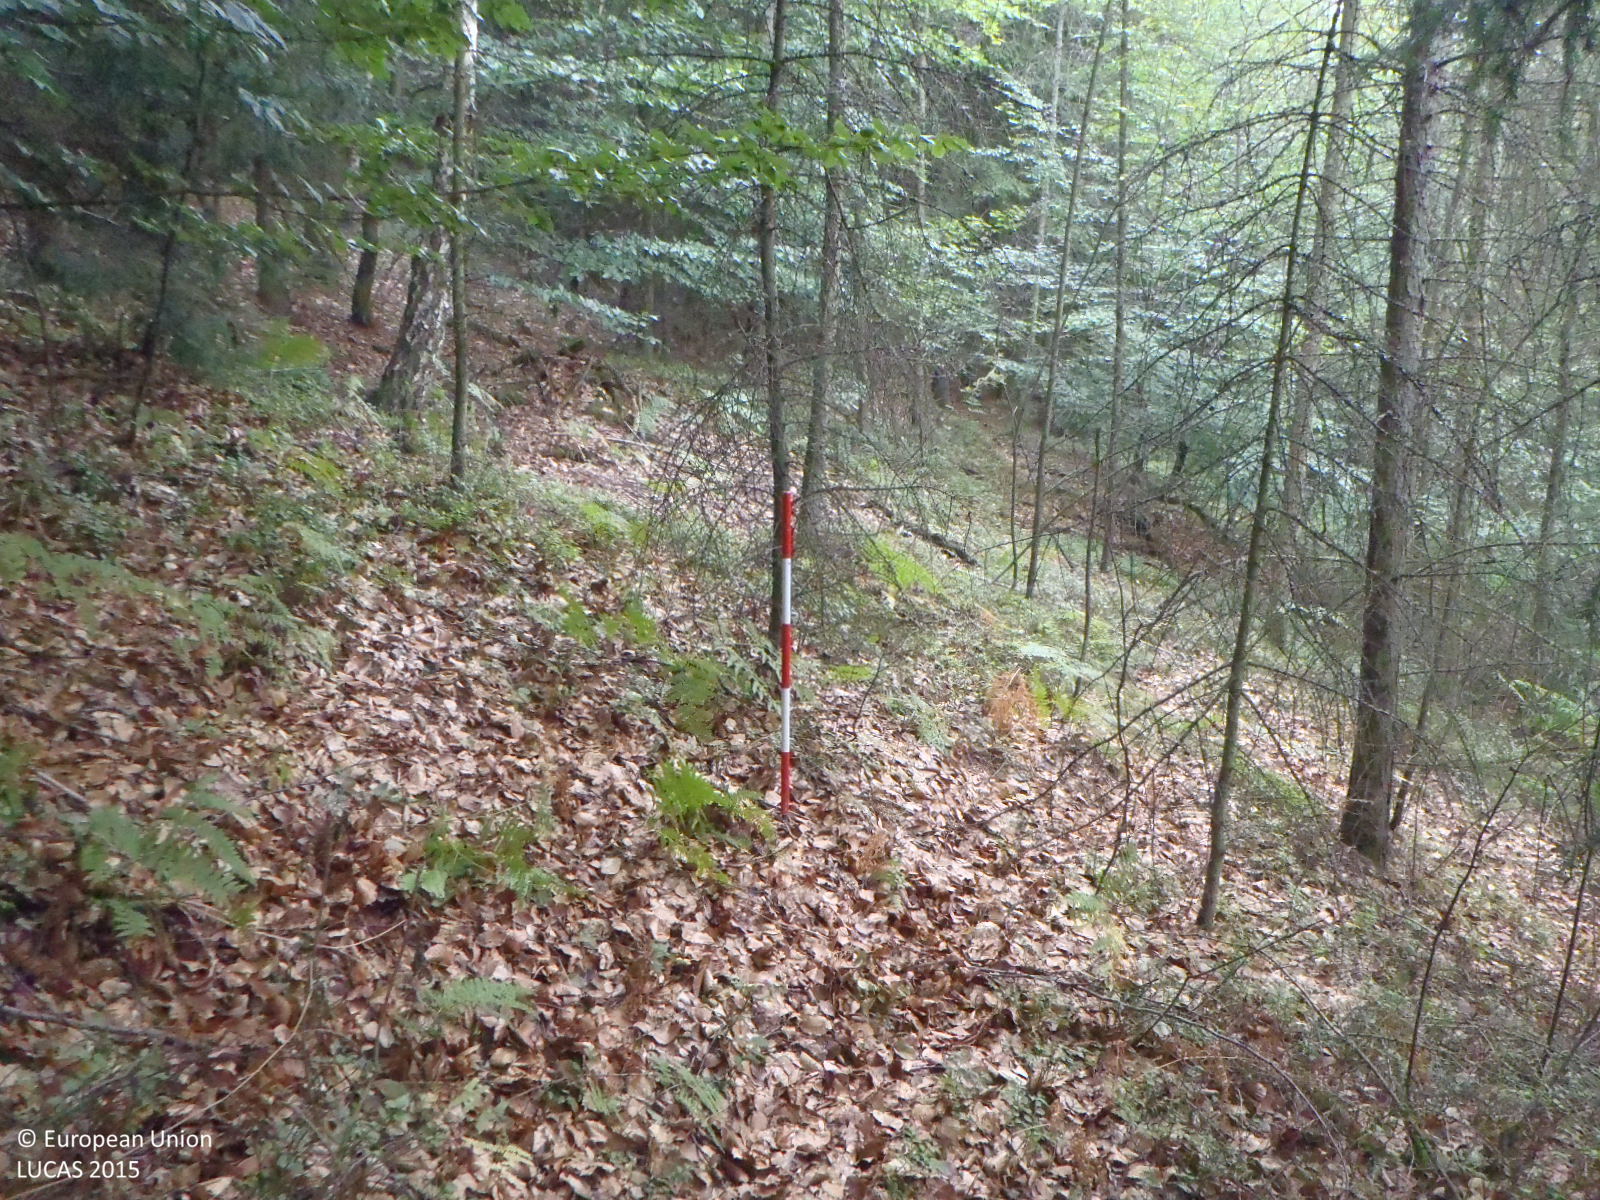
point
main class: Woodland
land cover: Other mixed woodland
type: hemiboreal forest and nemoral coniferous forest and mixed broadleaved-coniferous forest
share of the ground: > 75 %
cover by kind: coniferous forest trees 60 %, broadleaved forest trees 40 %
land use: Forestry
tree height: > 5 m
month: September
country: CZ
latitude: 50.7906
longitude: 14.2145
